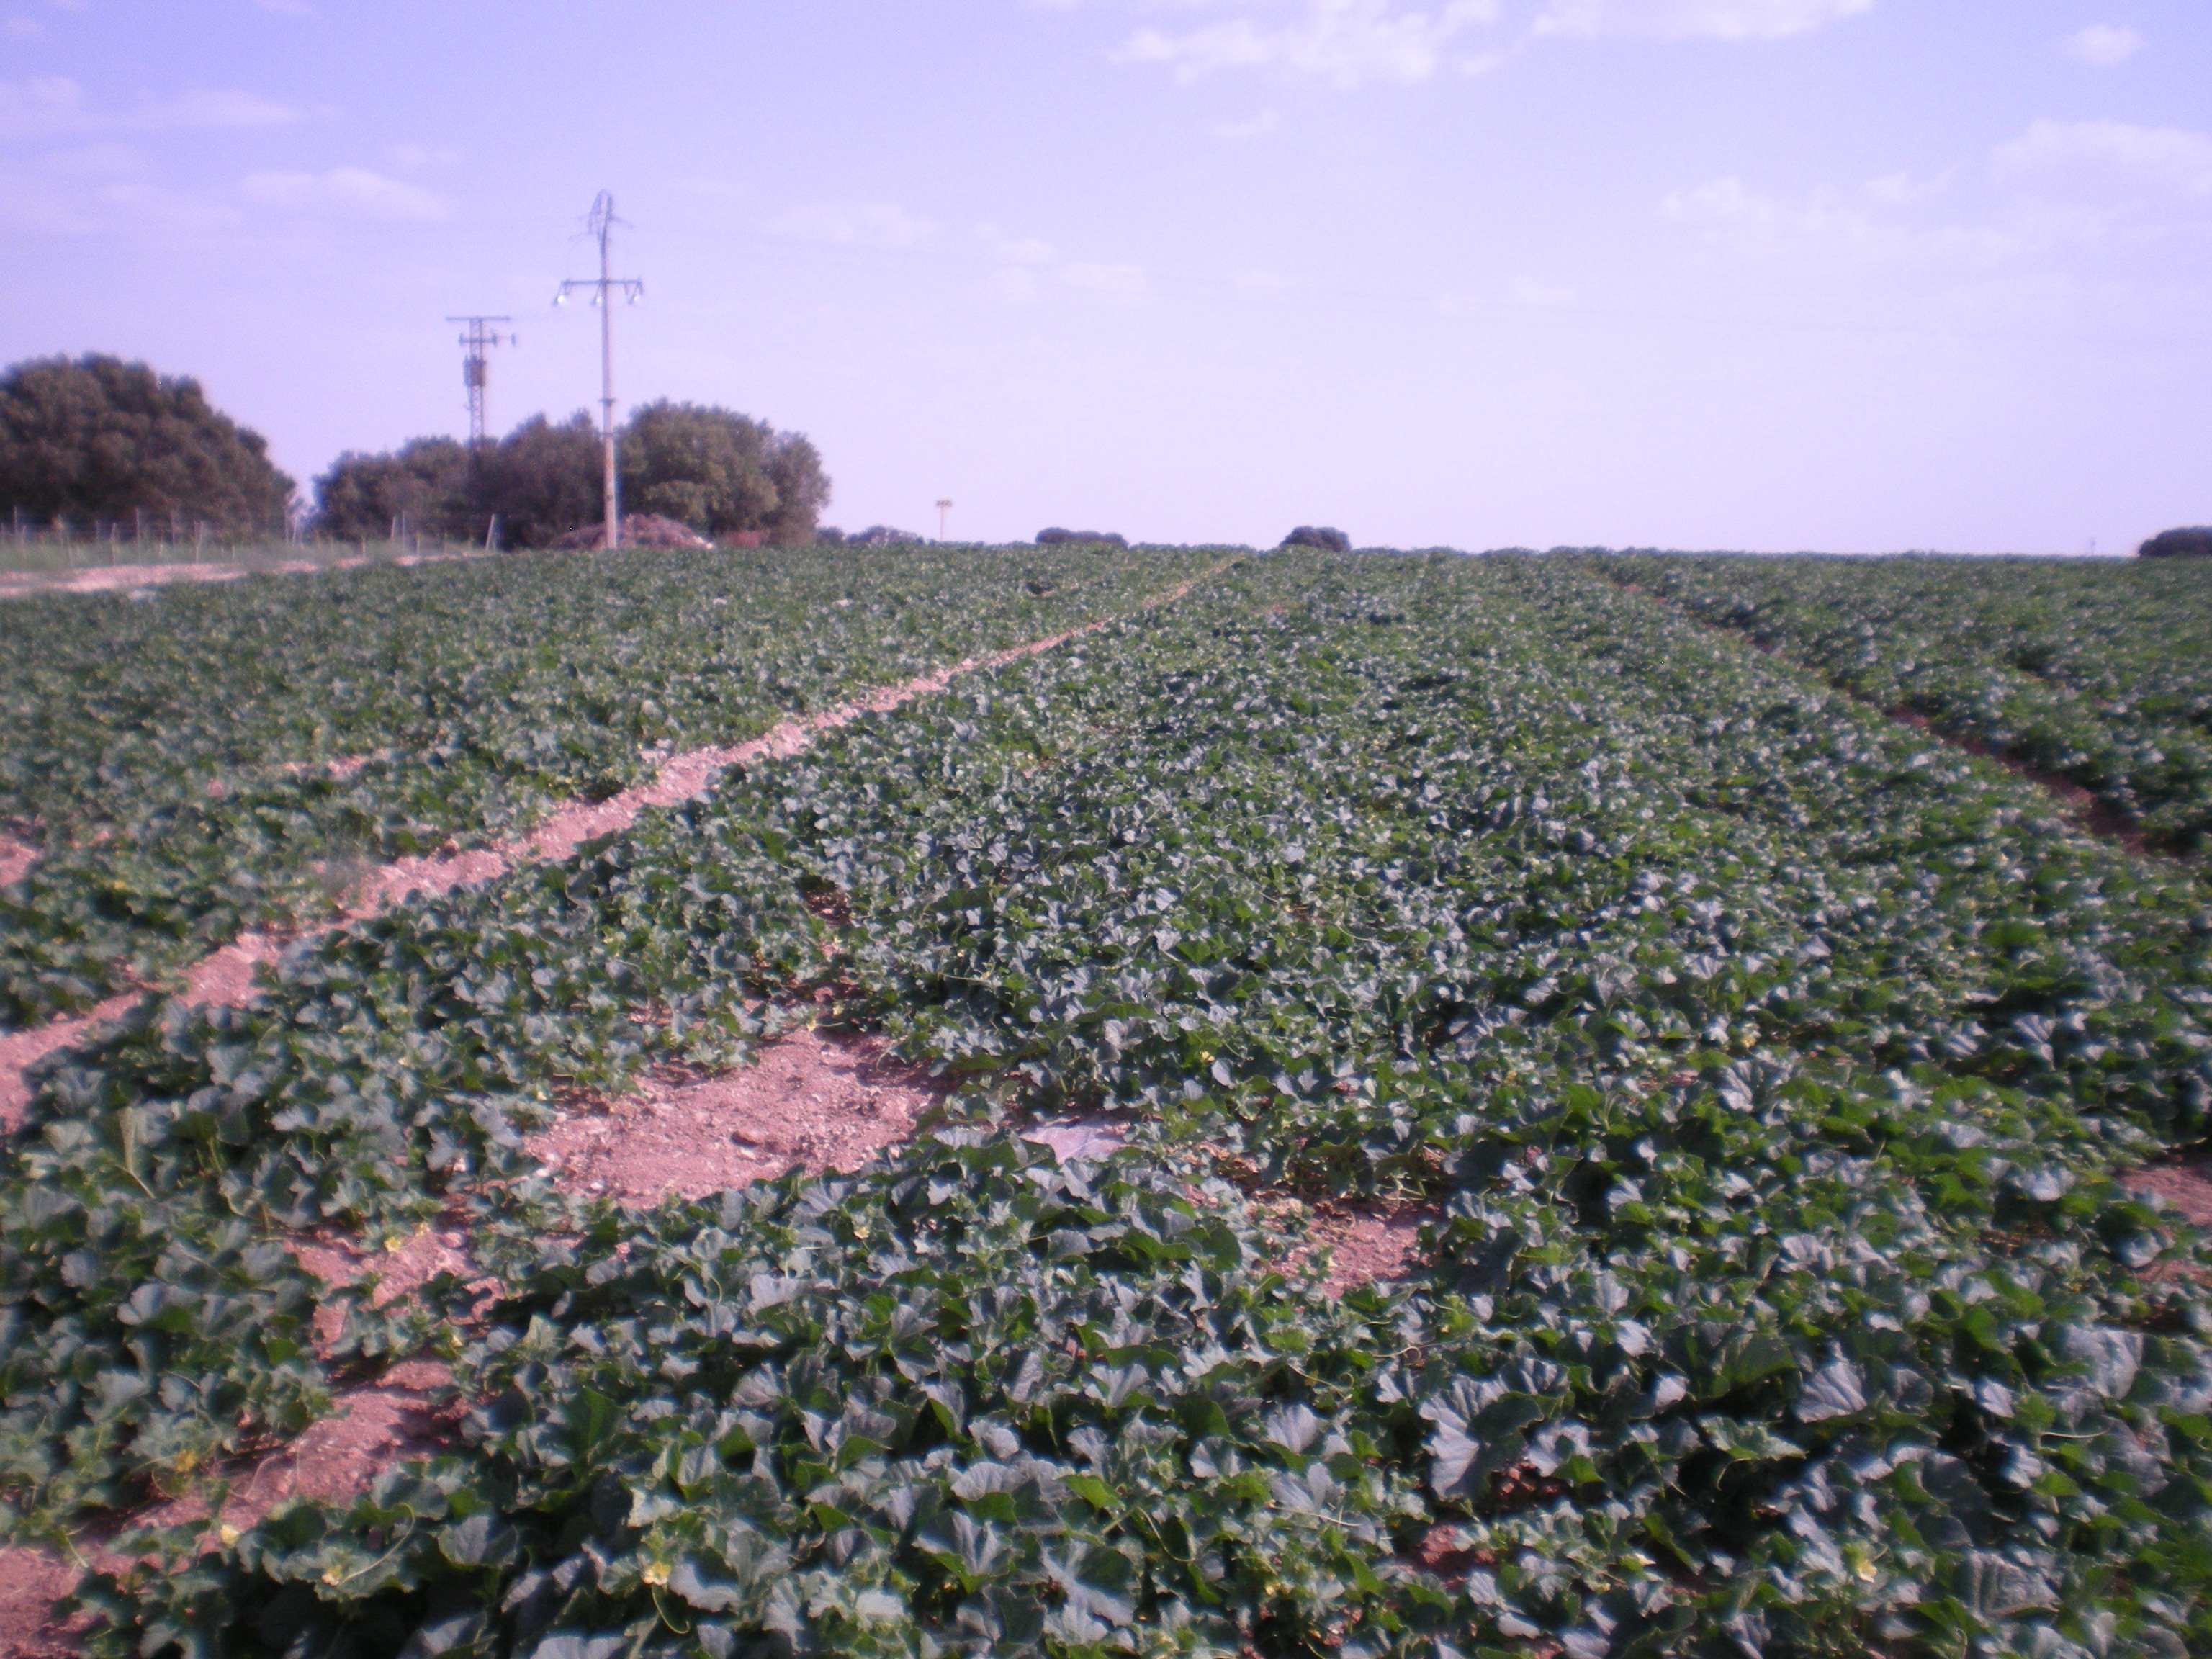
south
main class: Cropland
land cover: Other fresh vegetables
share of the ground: > 75 %
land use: Agriculture (excluding fallow land and kitchen gardens)
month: July
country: ES
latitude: 39.2675
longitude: -3.2881
